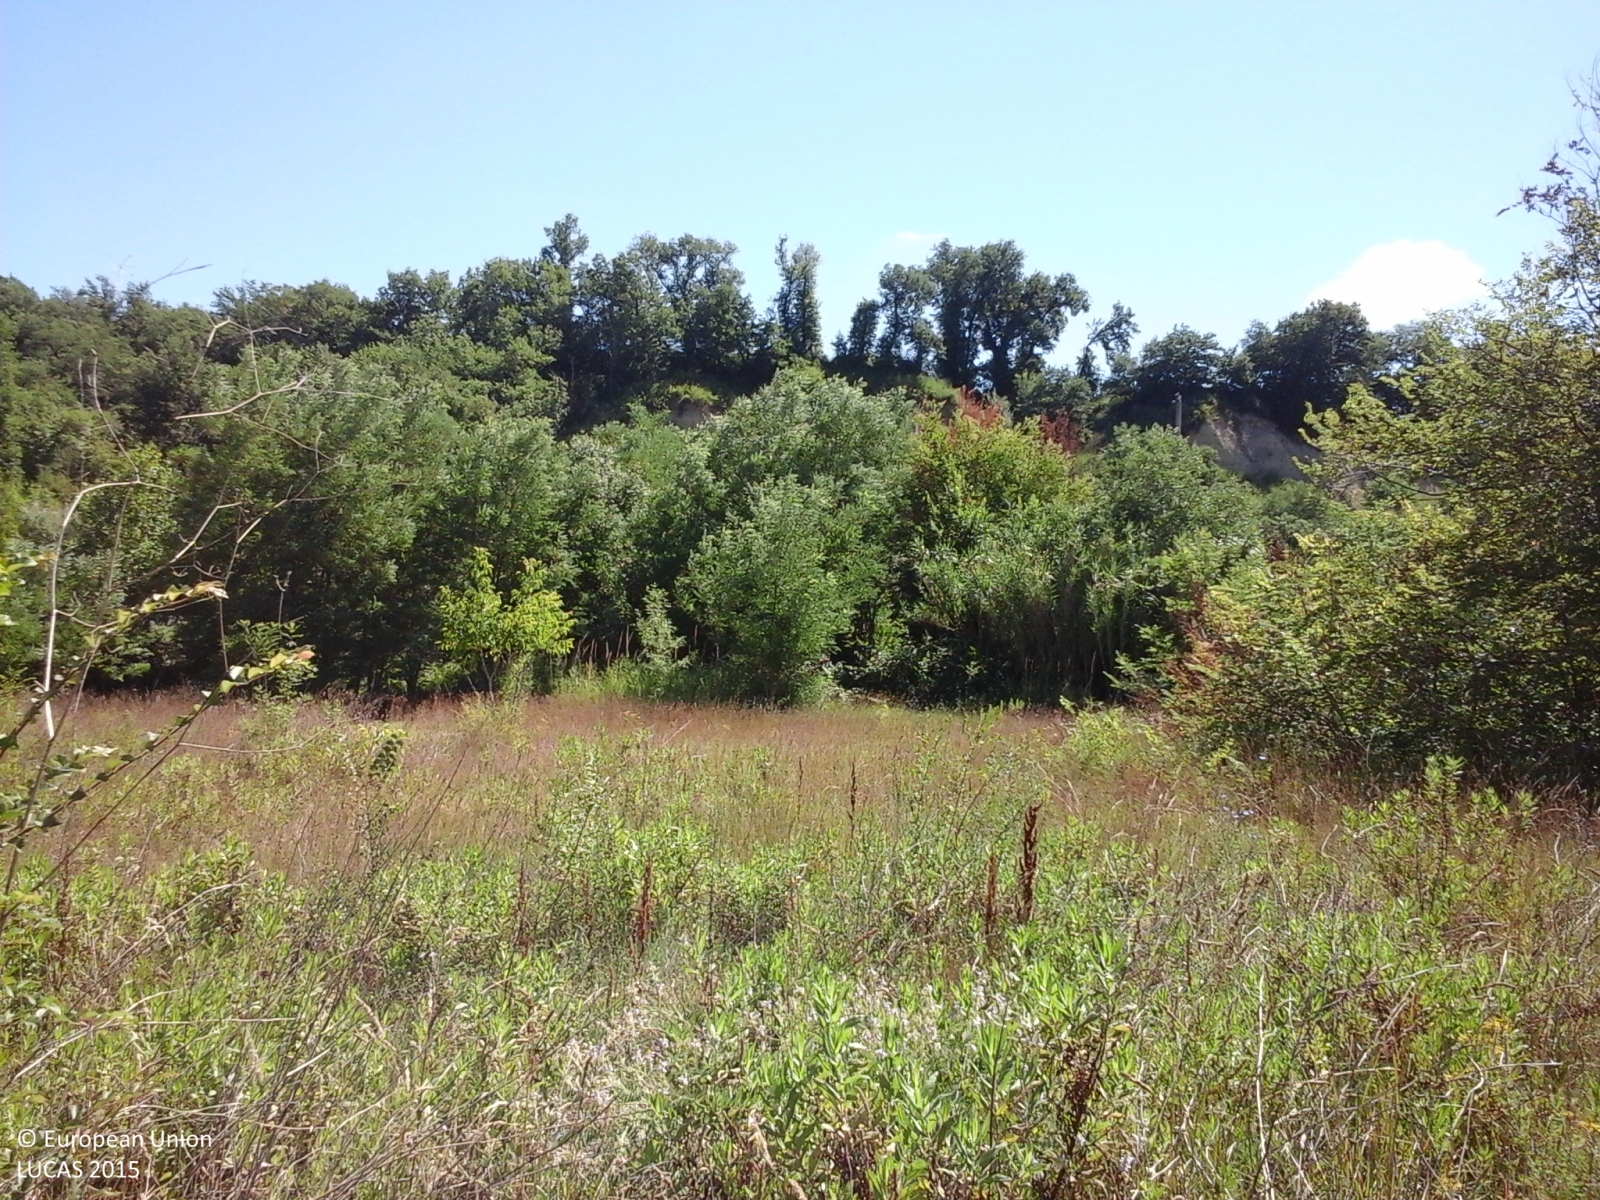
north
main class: Shrubland
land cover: Shrubland with sparse tree cover
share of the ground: > 75 %
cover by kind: shrubs 90 %, broadleaved forest trees 5 %, herbaceous plants 5 %
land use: Semi-natural and natural areas not in use
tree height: < 5 m
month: June
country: IT
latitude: 42.1284
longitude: 14.3051
